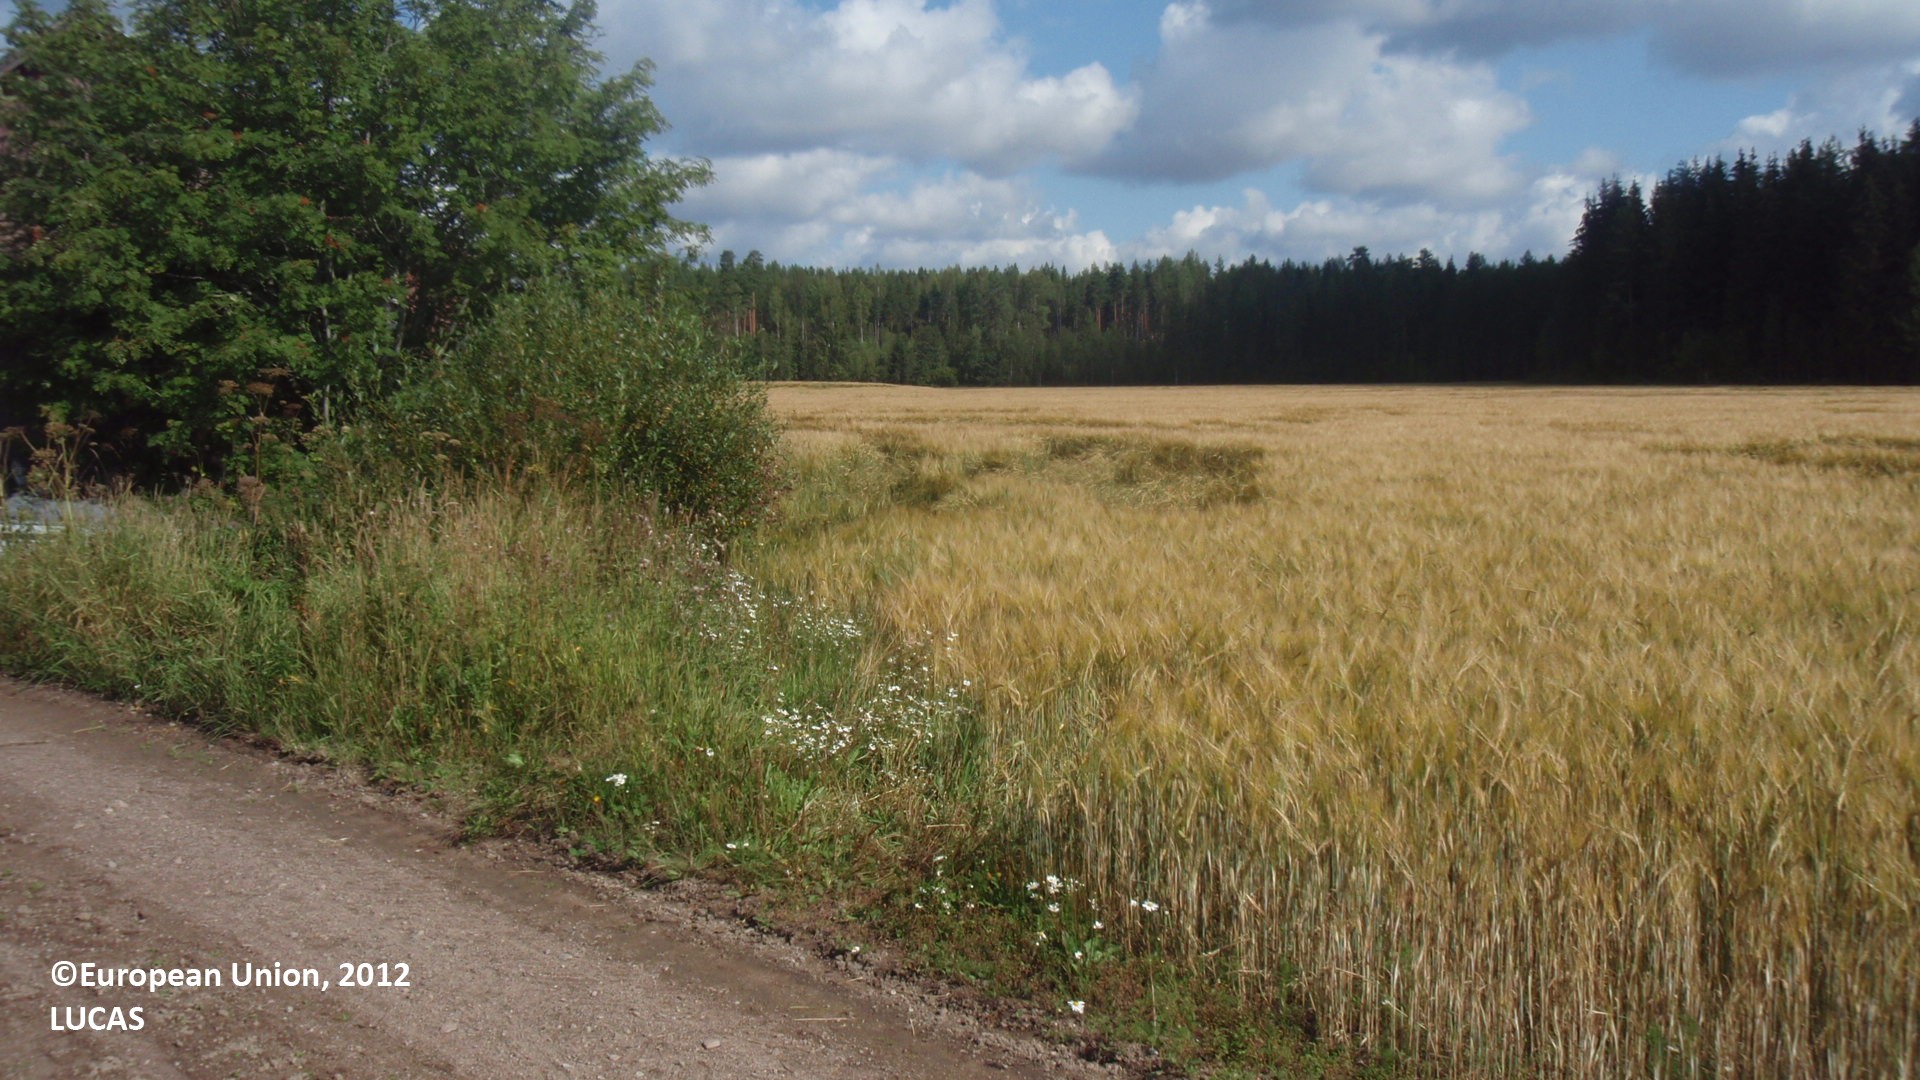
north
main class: Cropland
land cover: Temporary grasslands
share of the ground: > 75 %
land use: Agriculture (excluding fallow land and kitchen gardens)
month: August
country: FI
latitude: 60.7672
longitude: 26.6611
